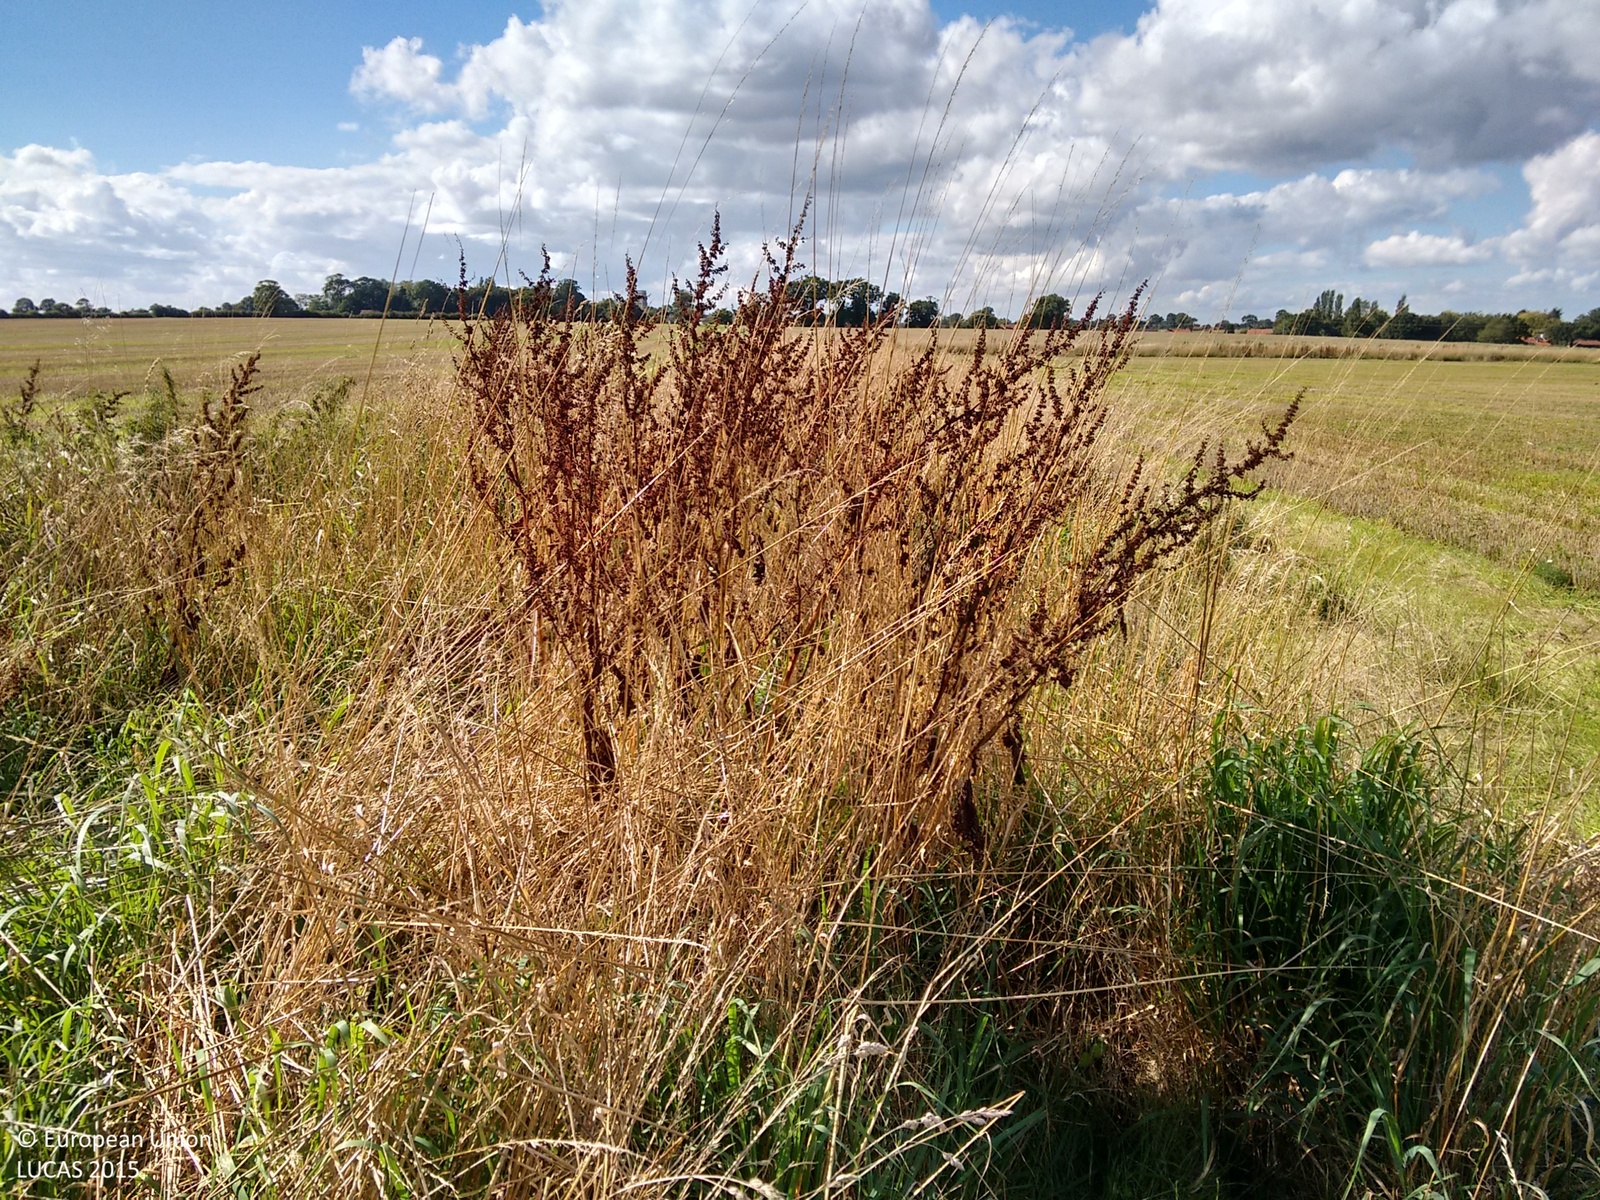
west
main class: Grassland
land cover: Grassland without tree/shrub cover
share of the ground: > 75 %
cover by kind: herbaceous plants 100 %
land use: Agriculture (excluding fallow land and kitchen gardens)
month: September
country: GB
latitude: 52.8171
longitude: 1.2994
